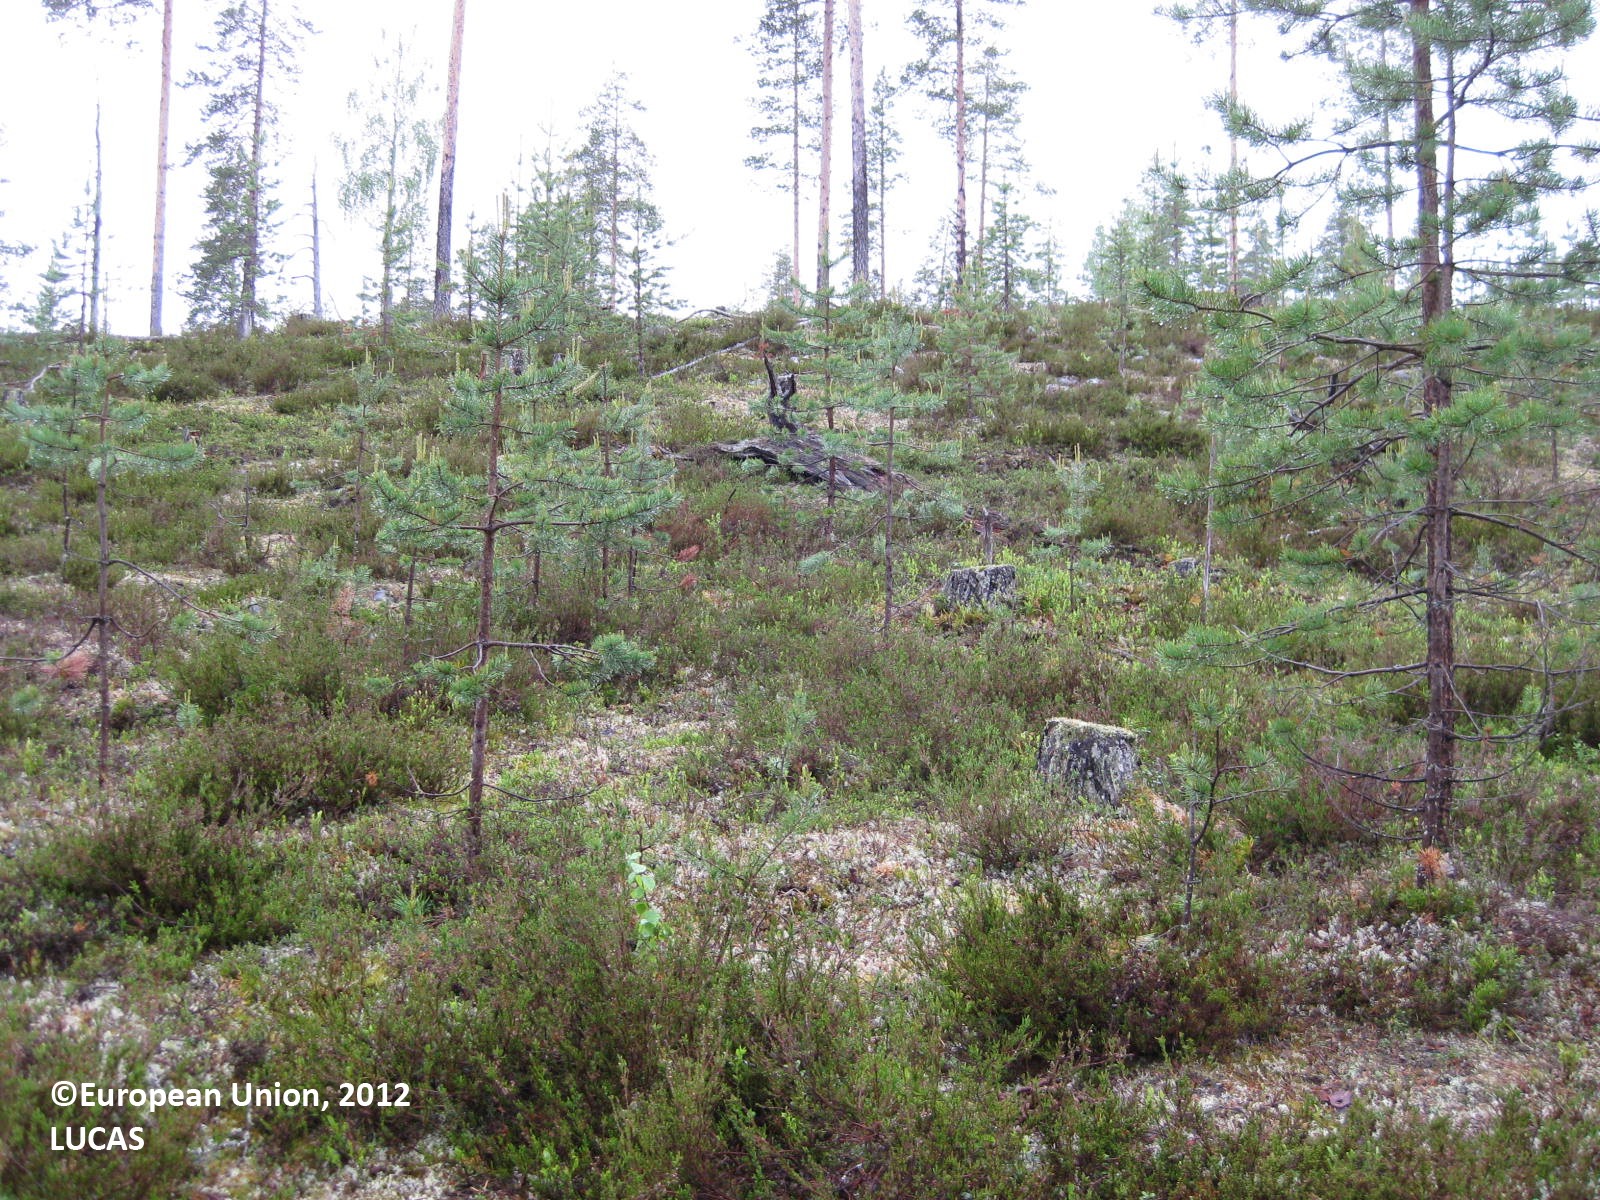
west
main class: Woodland
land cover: Pine dominated coniferous woodland
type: boreal forest
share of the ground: 50 - 75 %
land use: Forestry
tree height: > 5 m
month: June
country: FI
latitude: 65.4356
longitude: 29.6732
